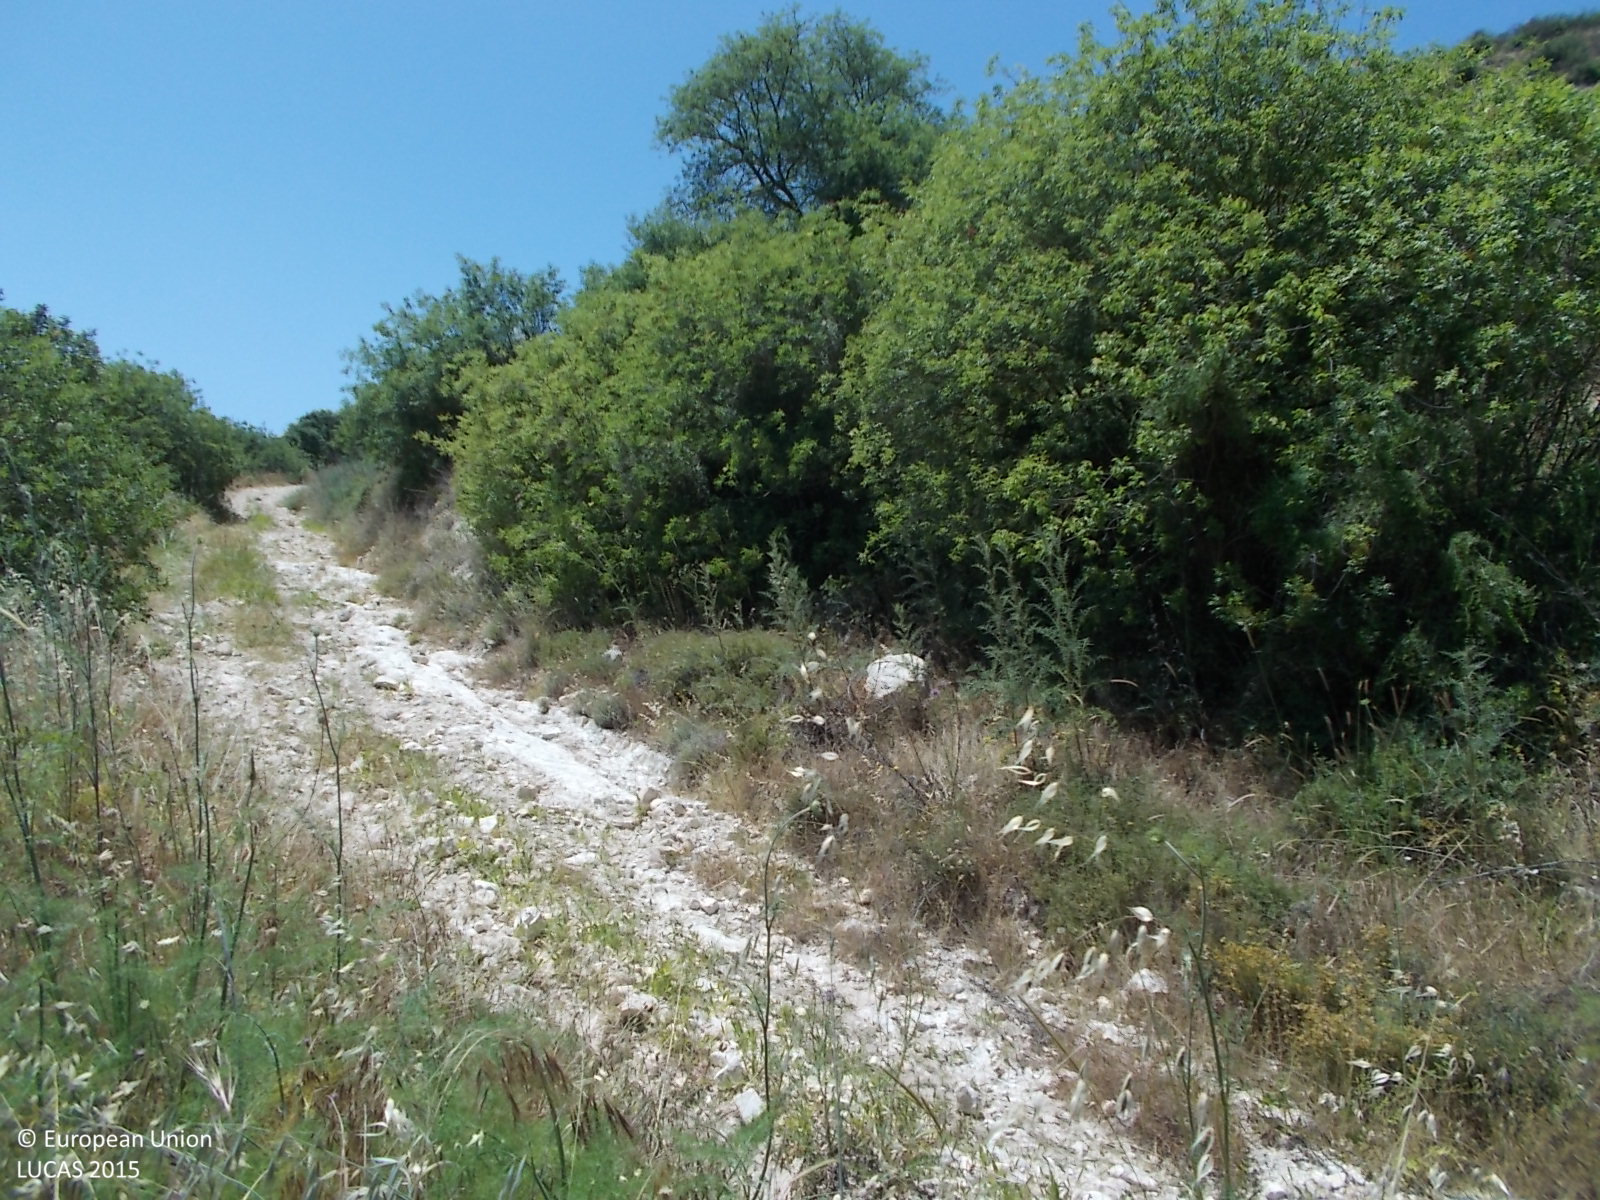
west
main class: Woodland
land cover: Broadleaved woodland
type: broadleaved evergreen forest
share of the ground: > 75 %
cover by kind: broadleaved forest trees 45 %, shrubs 30 %, herbaceous plants 10 %, consolidated bare surface 10 %, unconsolidated bare surface 5 %
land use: Semi-natural and natural areas not in use
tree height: > 5 m
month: May
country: CY
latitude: 34.8751
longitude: 32.4562
